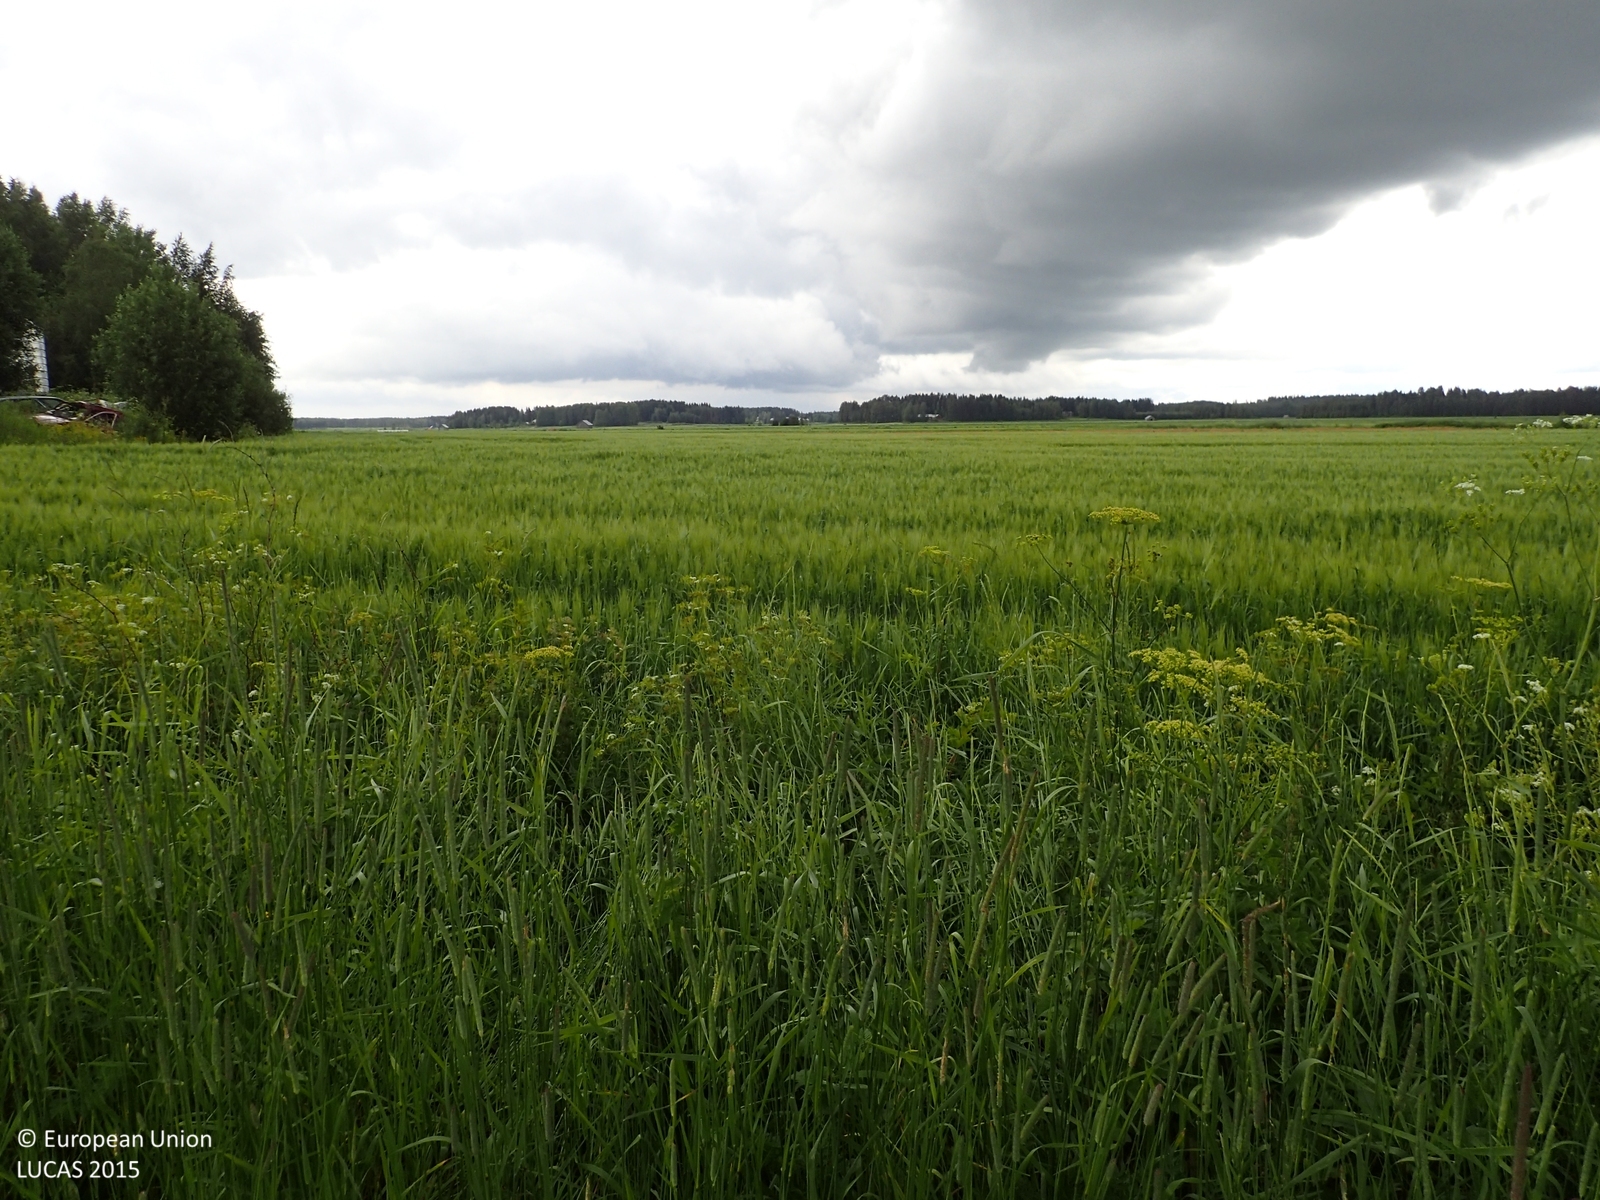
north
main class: Cropland
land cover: Arable land (only in case pi)
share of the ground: > 75 %
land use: Agriculture (excluding fallow land and kitchen gardens)
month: July
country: FI
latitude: 62.9234
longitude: 21.6801
